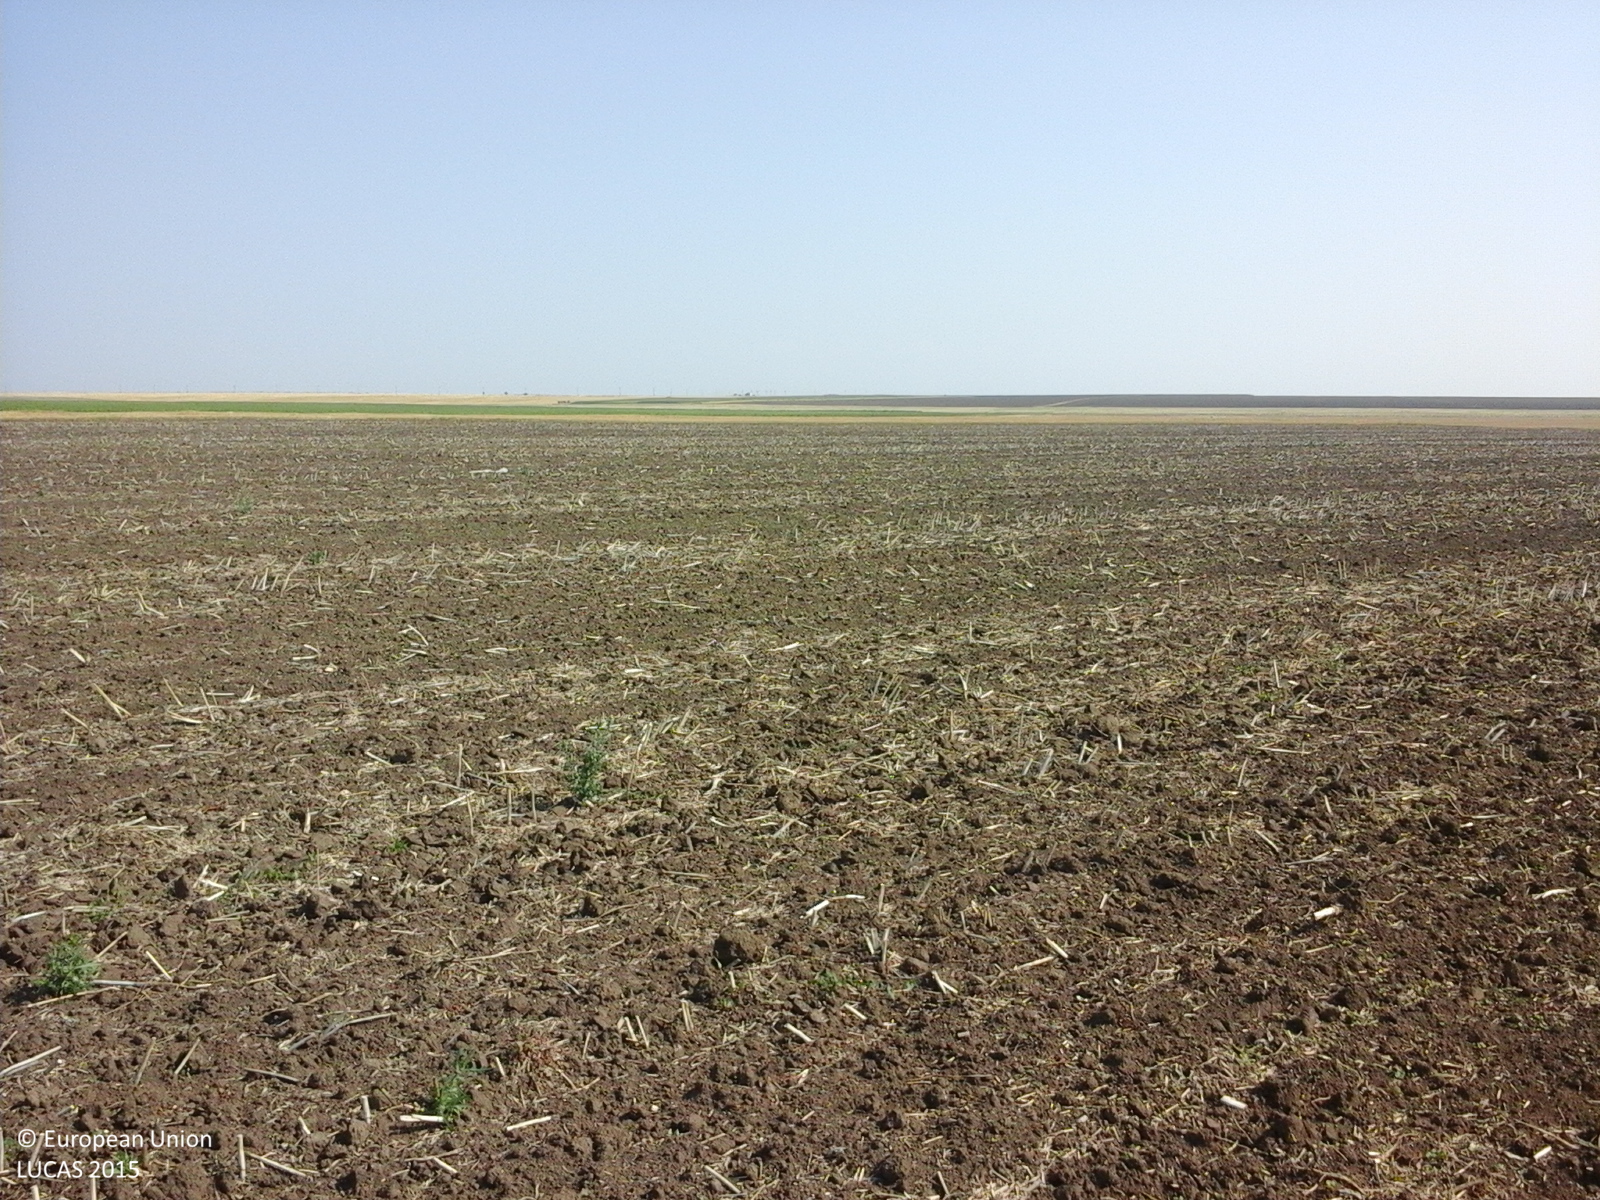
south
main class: Cropland
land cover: Rape and turnip rape
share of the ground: < 10 %
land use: Agriculture (excluding fallow land and kitchen gardens)
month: July
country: RO
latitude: 44.7214
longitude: 27.3227
